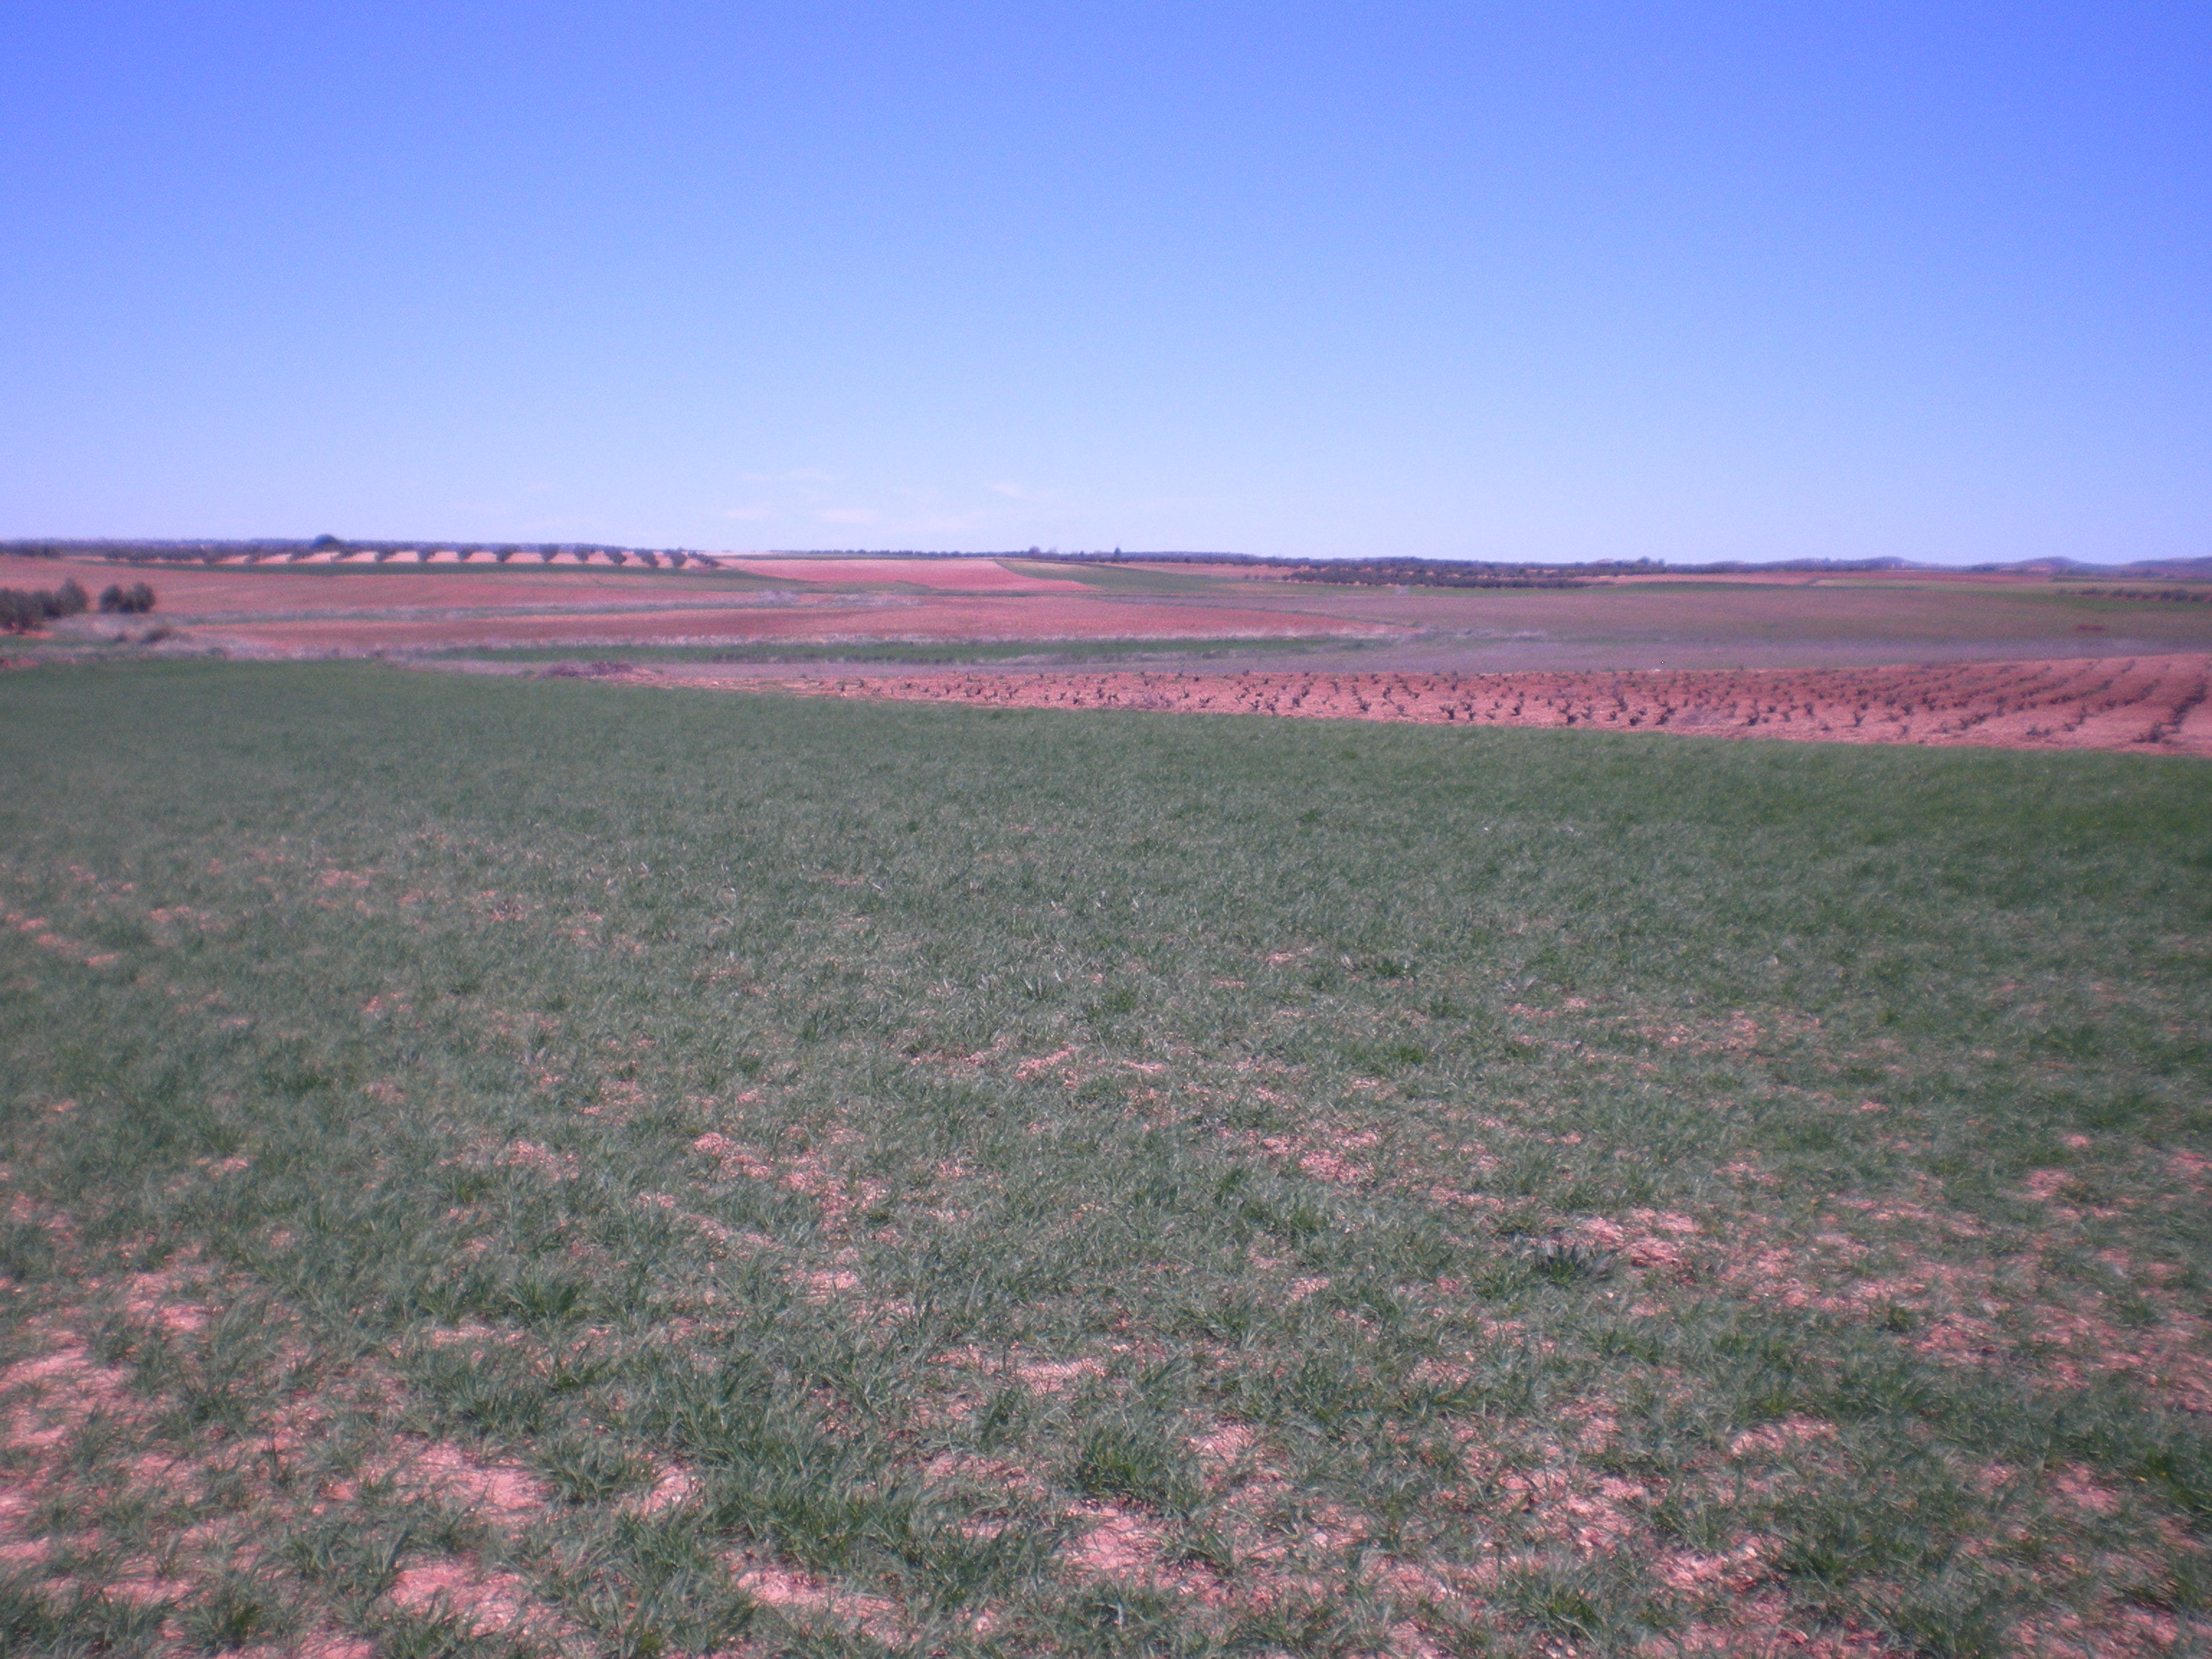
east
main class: Cropland
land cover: Barley
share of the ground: 25 - 50 %
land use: Agriculture (excluding fallow land and kitchen gardens)
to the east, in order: Barley; Grass margins; Vineyards; Grass margins; Spontaneously vegetated surfaces; Grass margins; Barley; Grass margins; Rivers and streams; Grass margins; Other bare soil
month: April
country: ES
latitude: 38.7693
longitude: -3.0478
